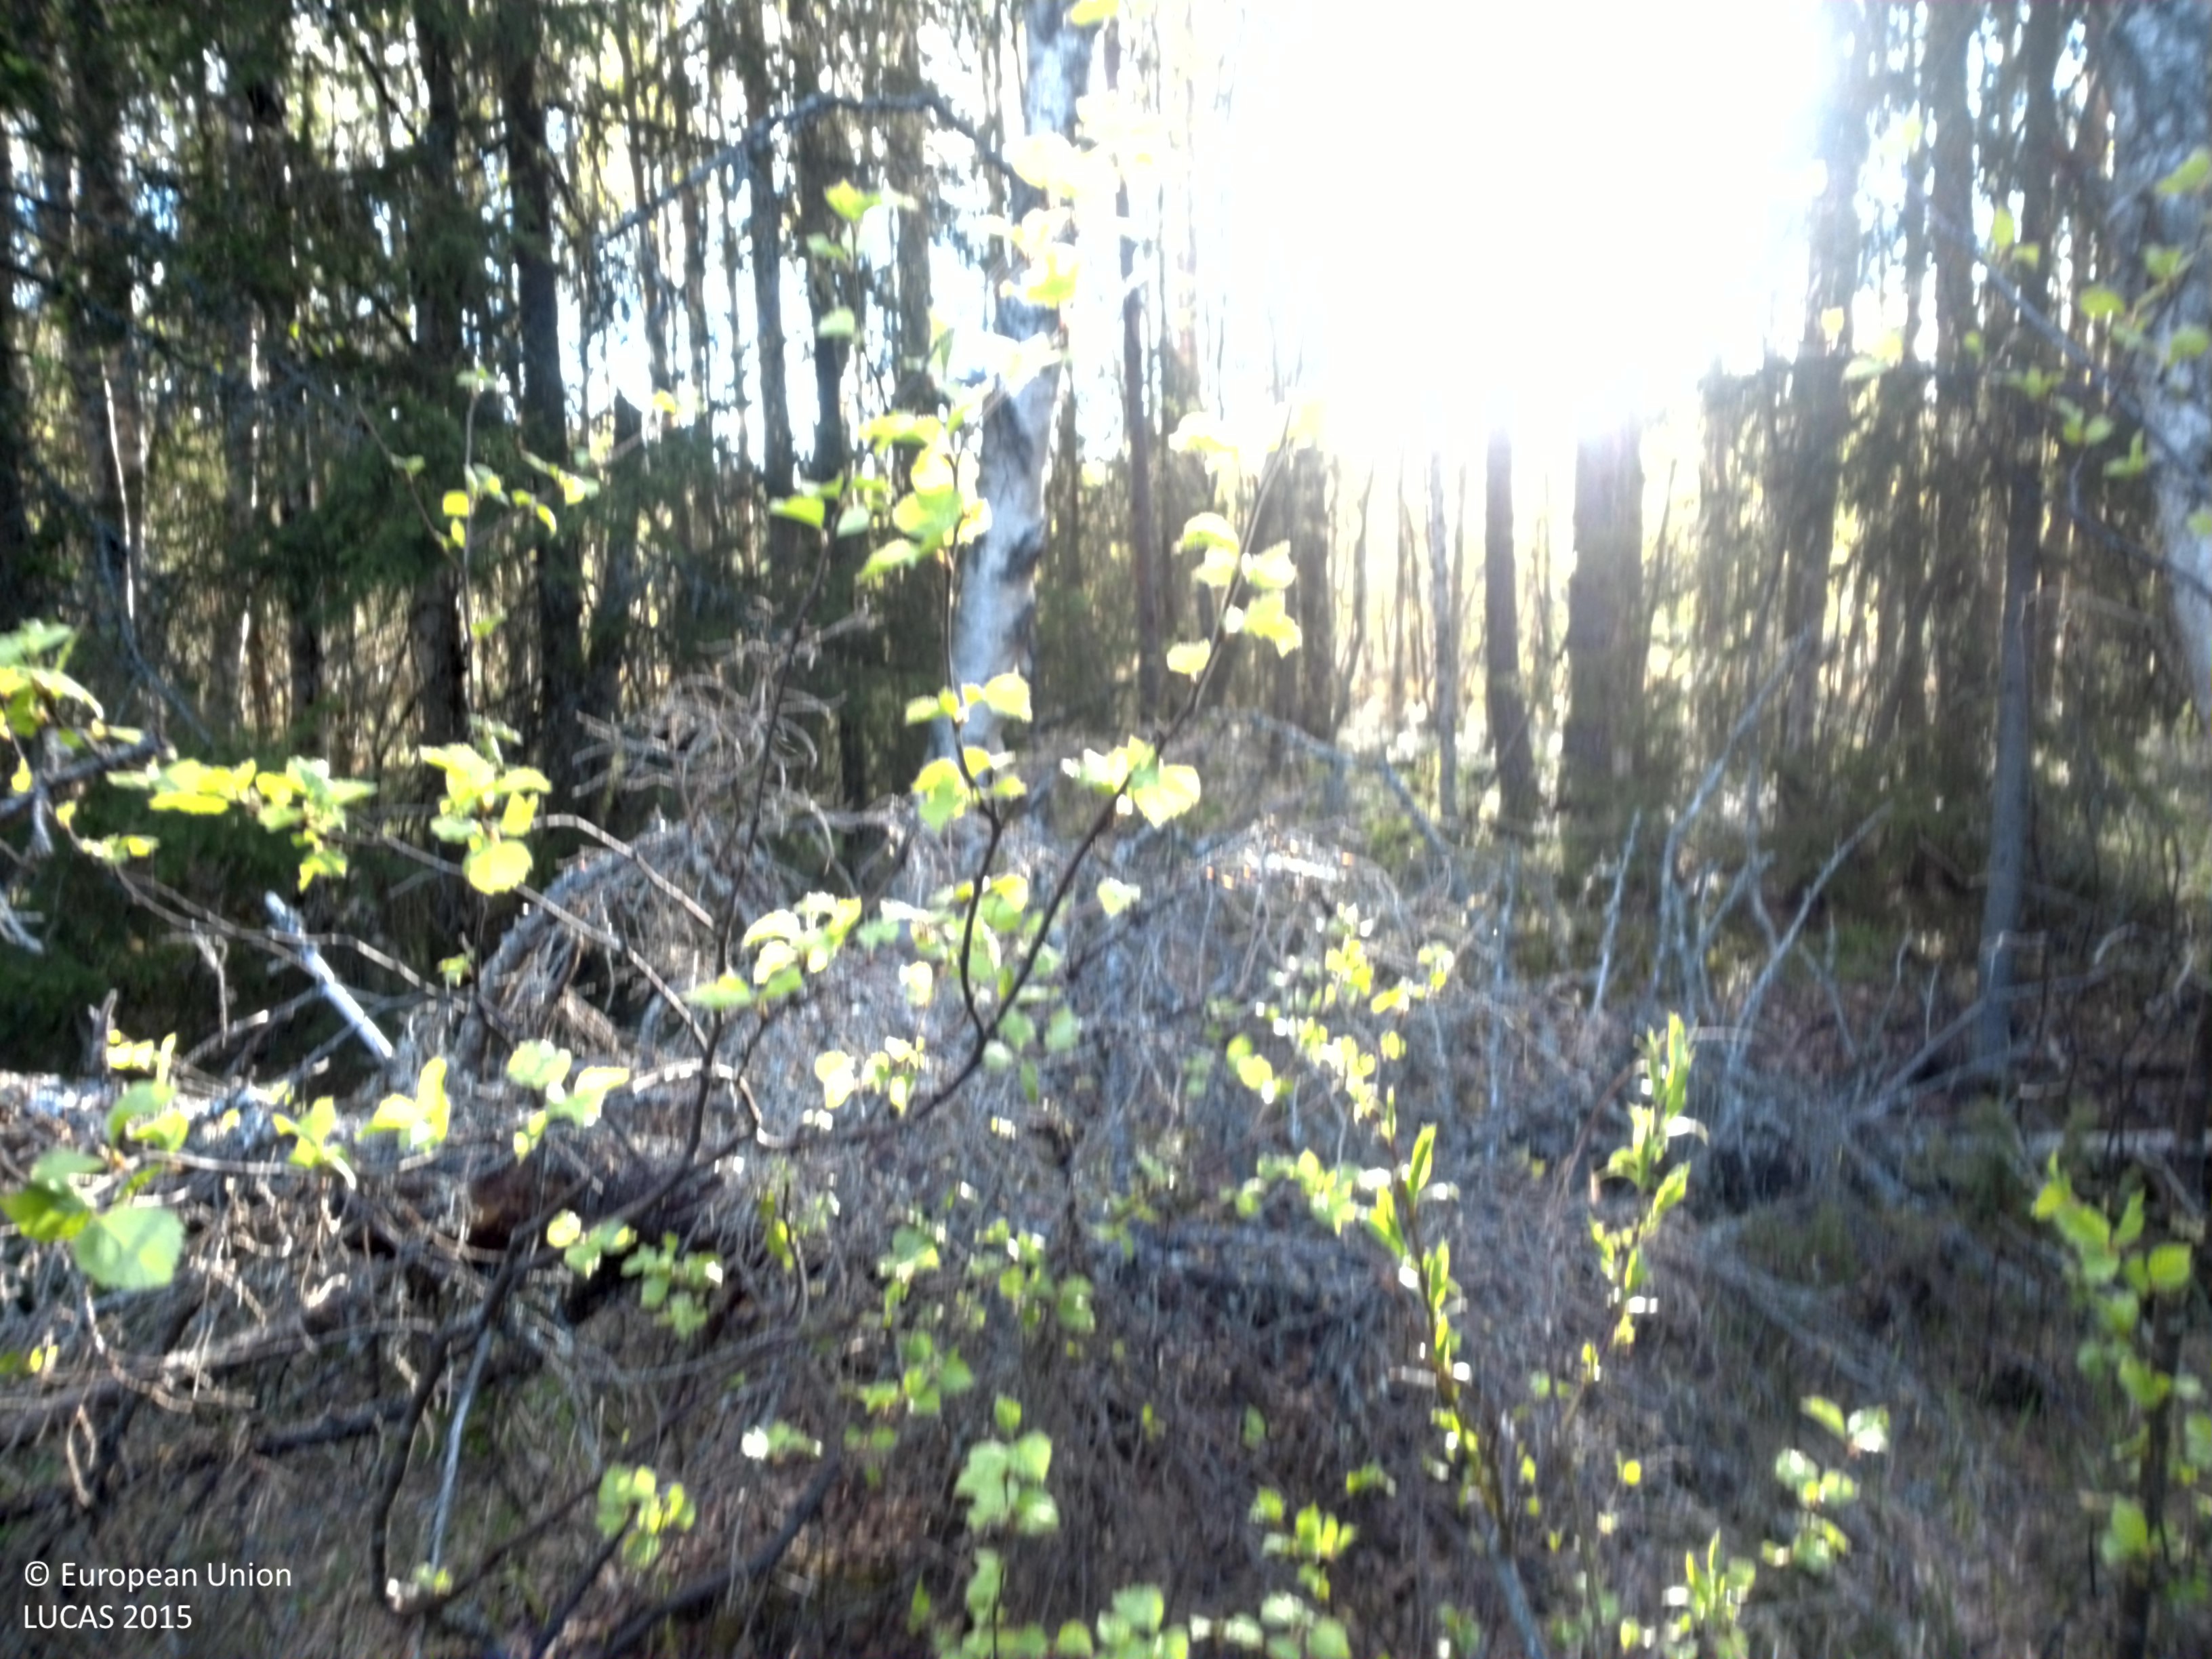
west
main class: Woodland
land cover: Other mixed woodland
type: boreal forest
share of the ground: 25 - 50 %
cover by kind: herbaceous plants 35 %, broadleaved forest trees 30 %, shrubs 20 %, coniferous forest trees 10 %
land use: Forestry
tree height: > 5 m
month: June
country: SE
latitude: 64.2212
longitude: 17.4914
